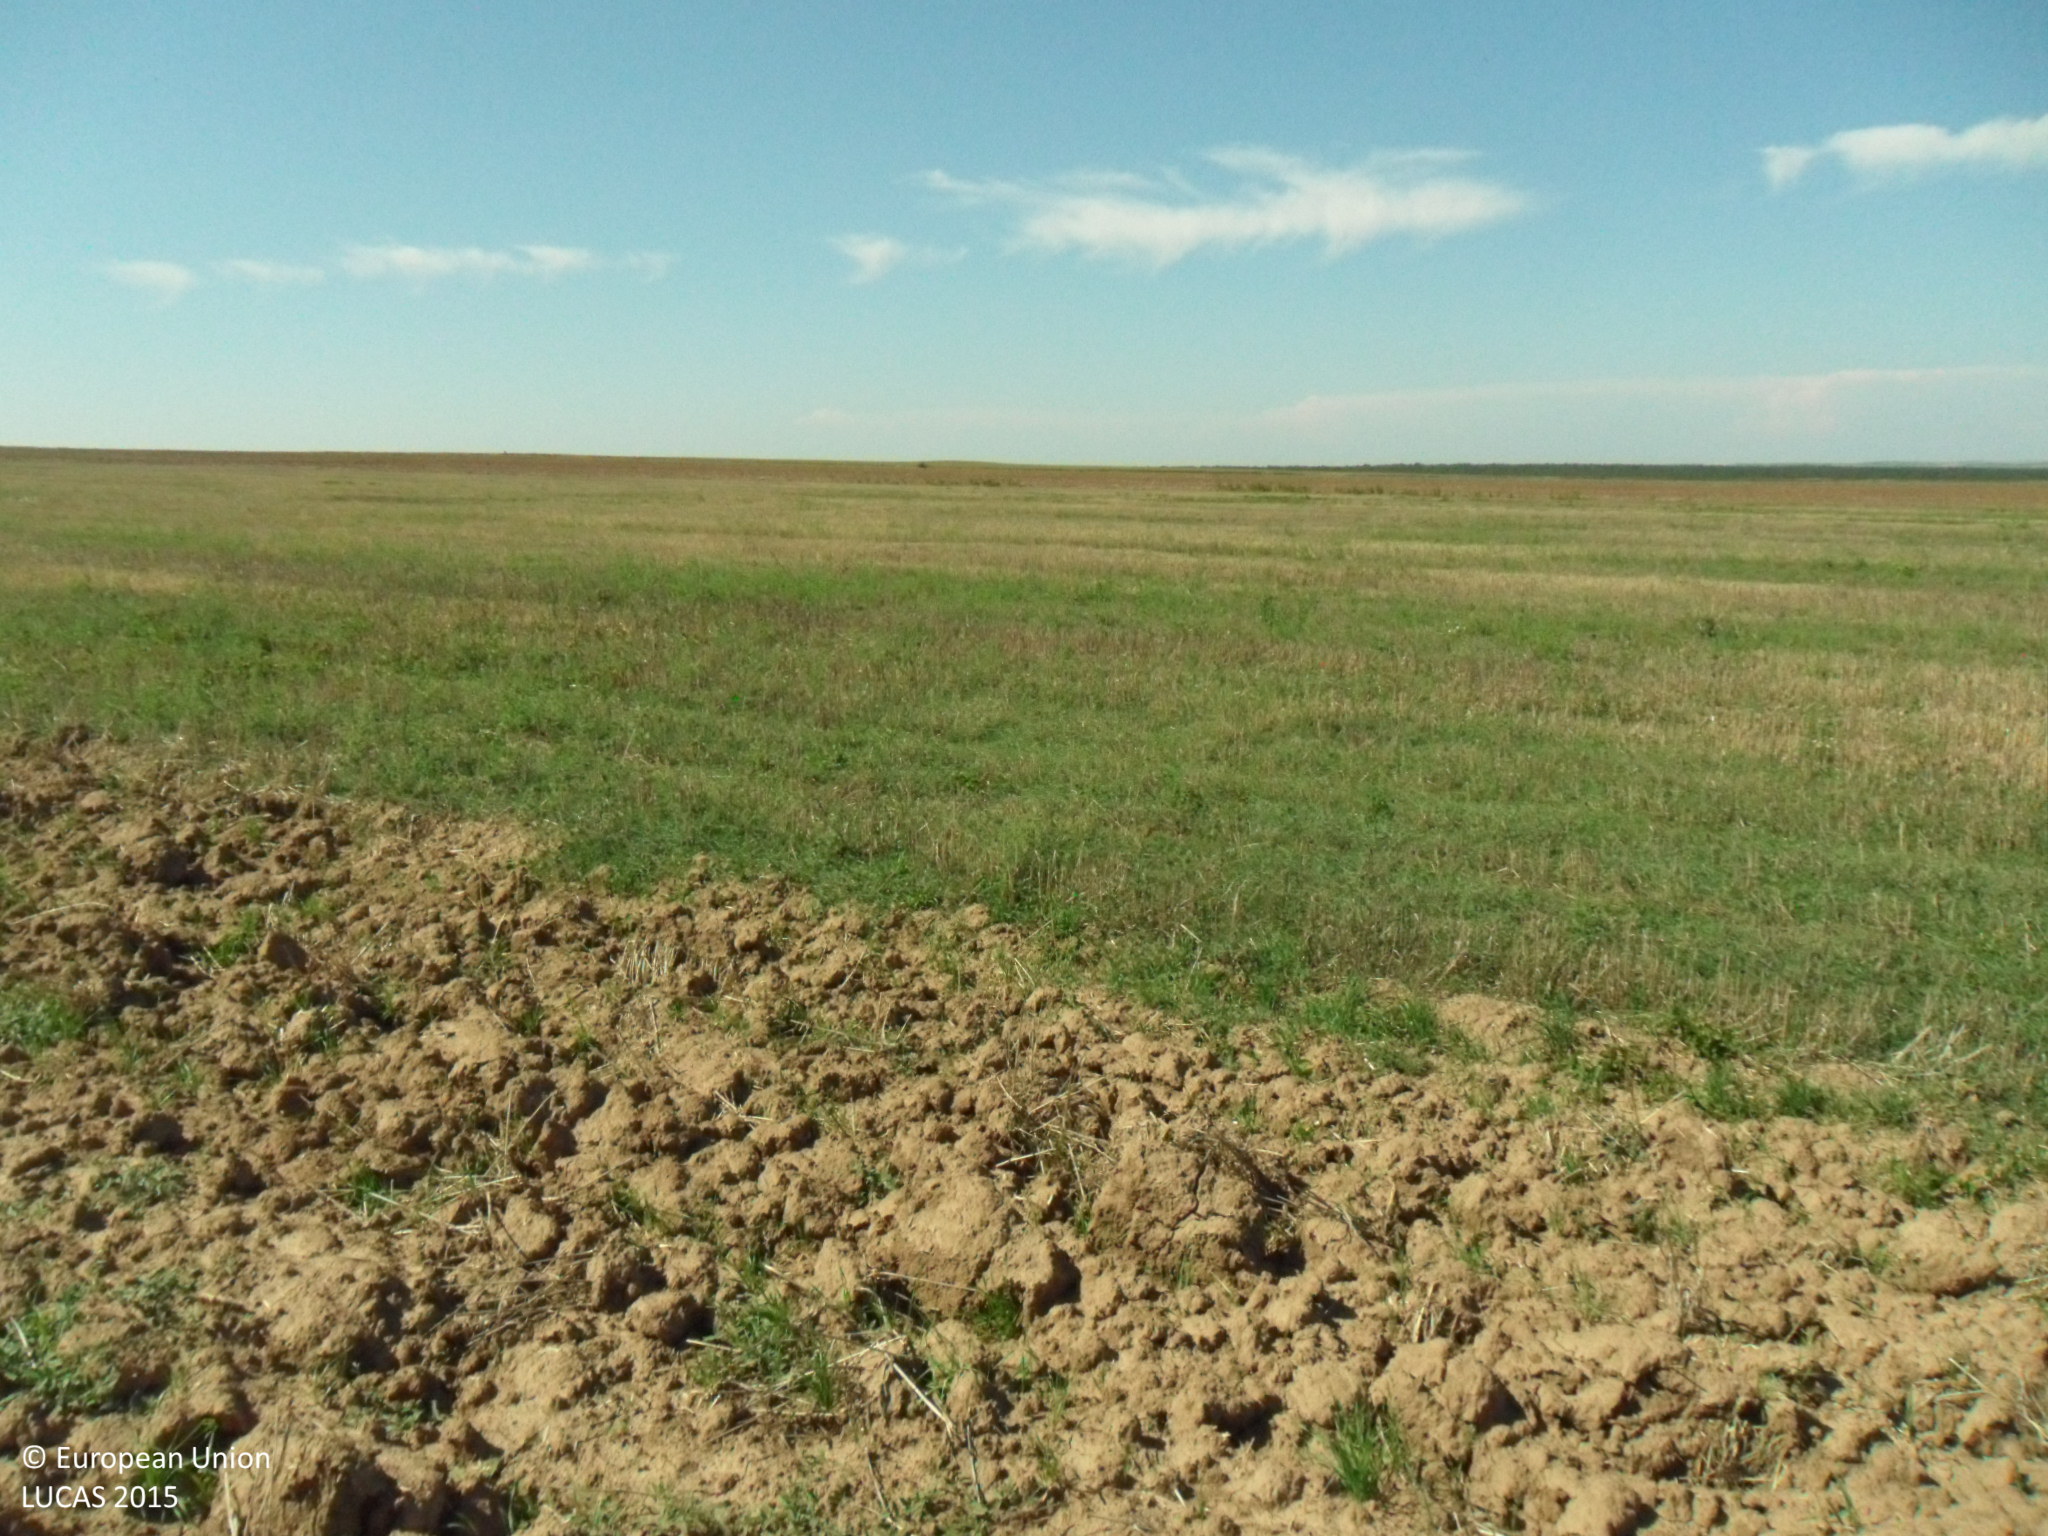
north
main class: Cropland
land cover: Nurseries
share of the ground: 50 - 75 %
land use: Forestry
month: September
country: BG
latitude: 43.5686
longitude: 27.1722
